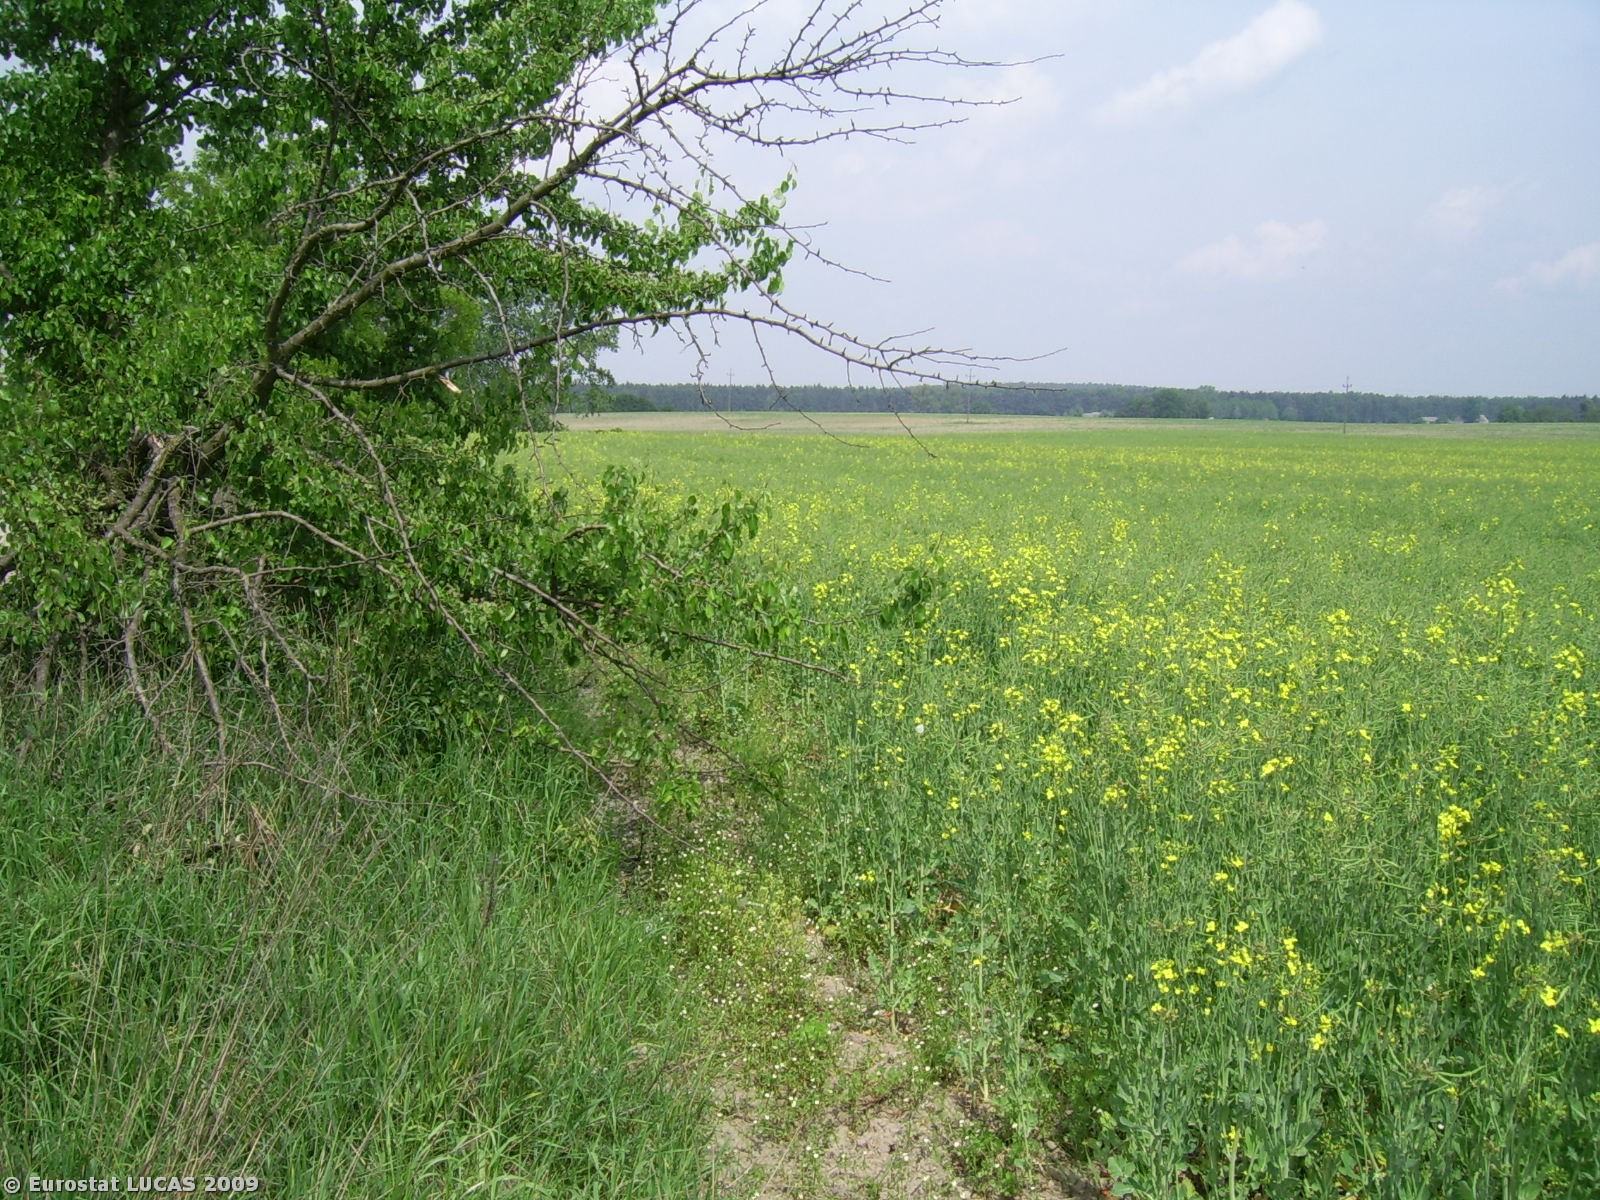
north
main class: Cropland
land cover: Rape and turnip rape
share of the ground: > 75 %
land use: Agriculture (excluding fallow land and kitchen gardens)
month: May
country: PL
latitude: 52.9201
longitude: 18.0022
